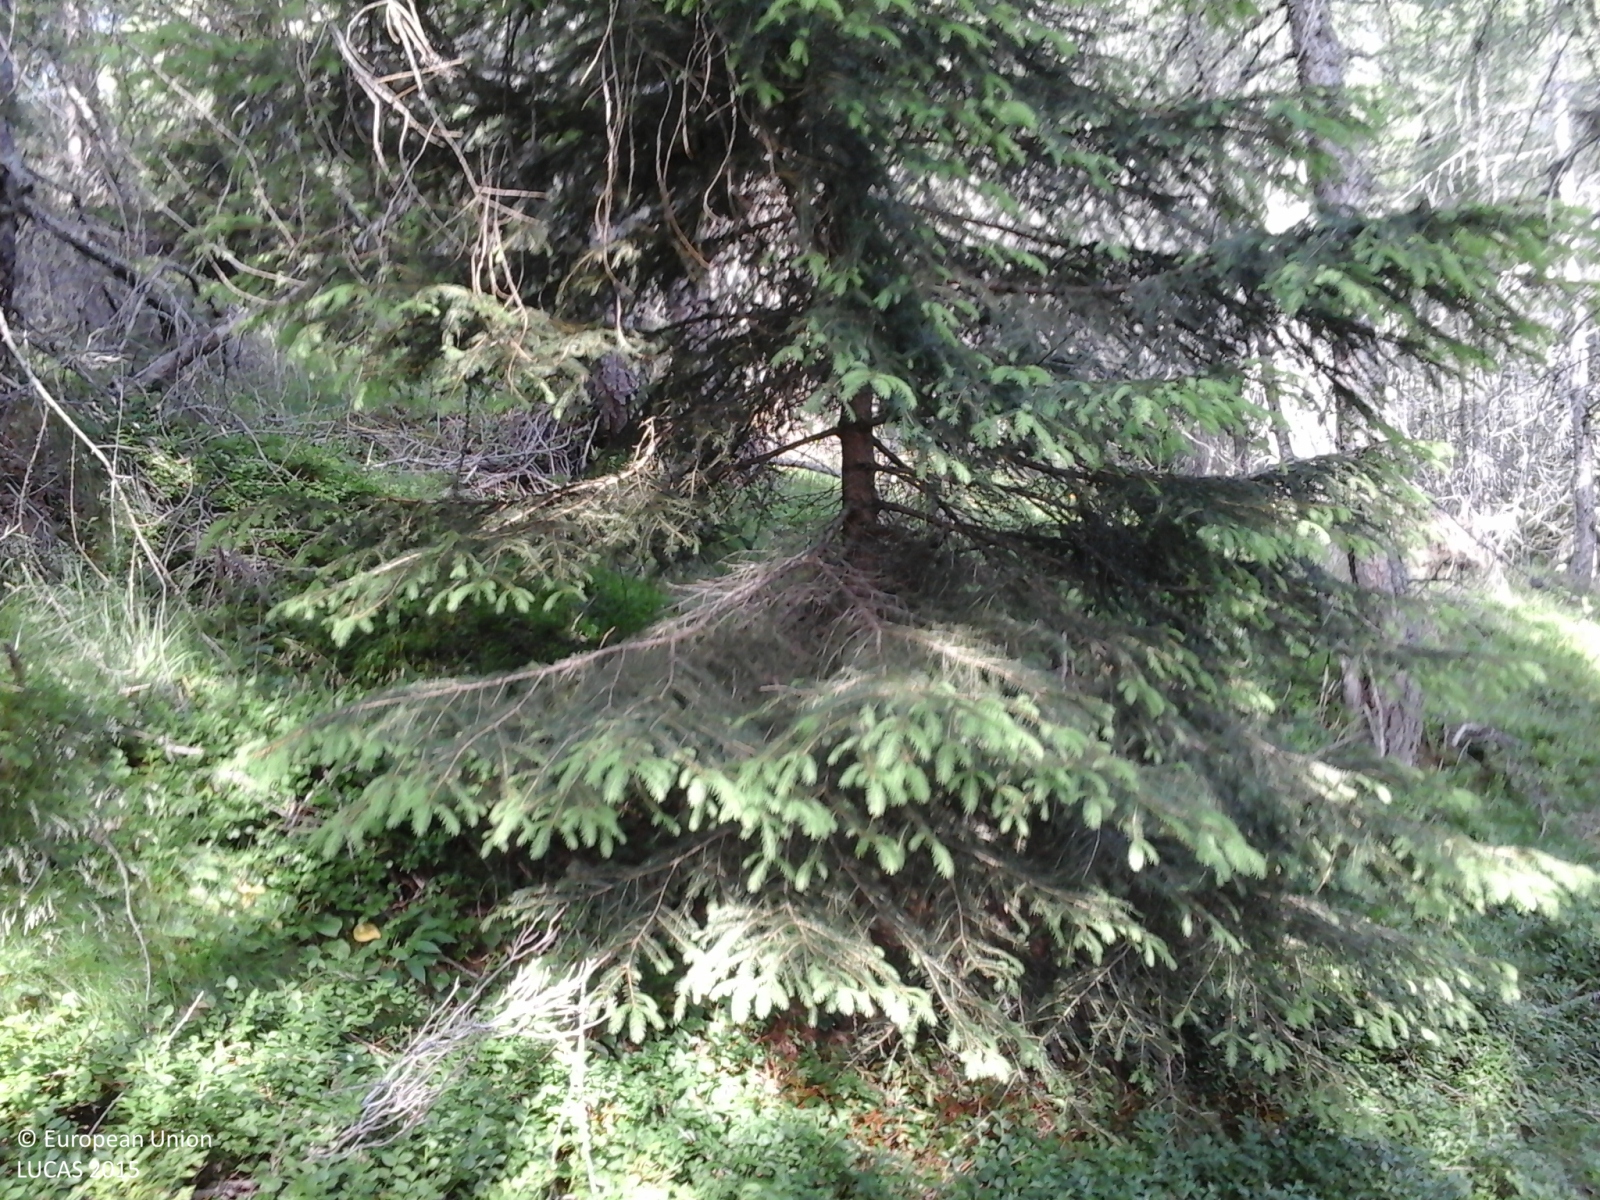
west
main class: Woodland
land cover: Spruce dominated coniferous woodland
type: alpine coniferous forest
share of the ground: > 75 %
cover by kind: coniferous forest trees 100 %
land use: Agriculture (excluding fallow land and kitchen gardens)
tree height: > 5 m
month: July
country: IT
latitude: 46.1888
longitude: 10.2458
